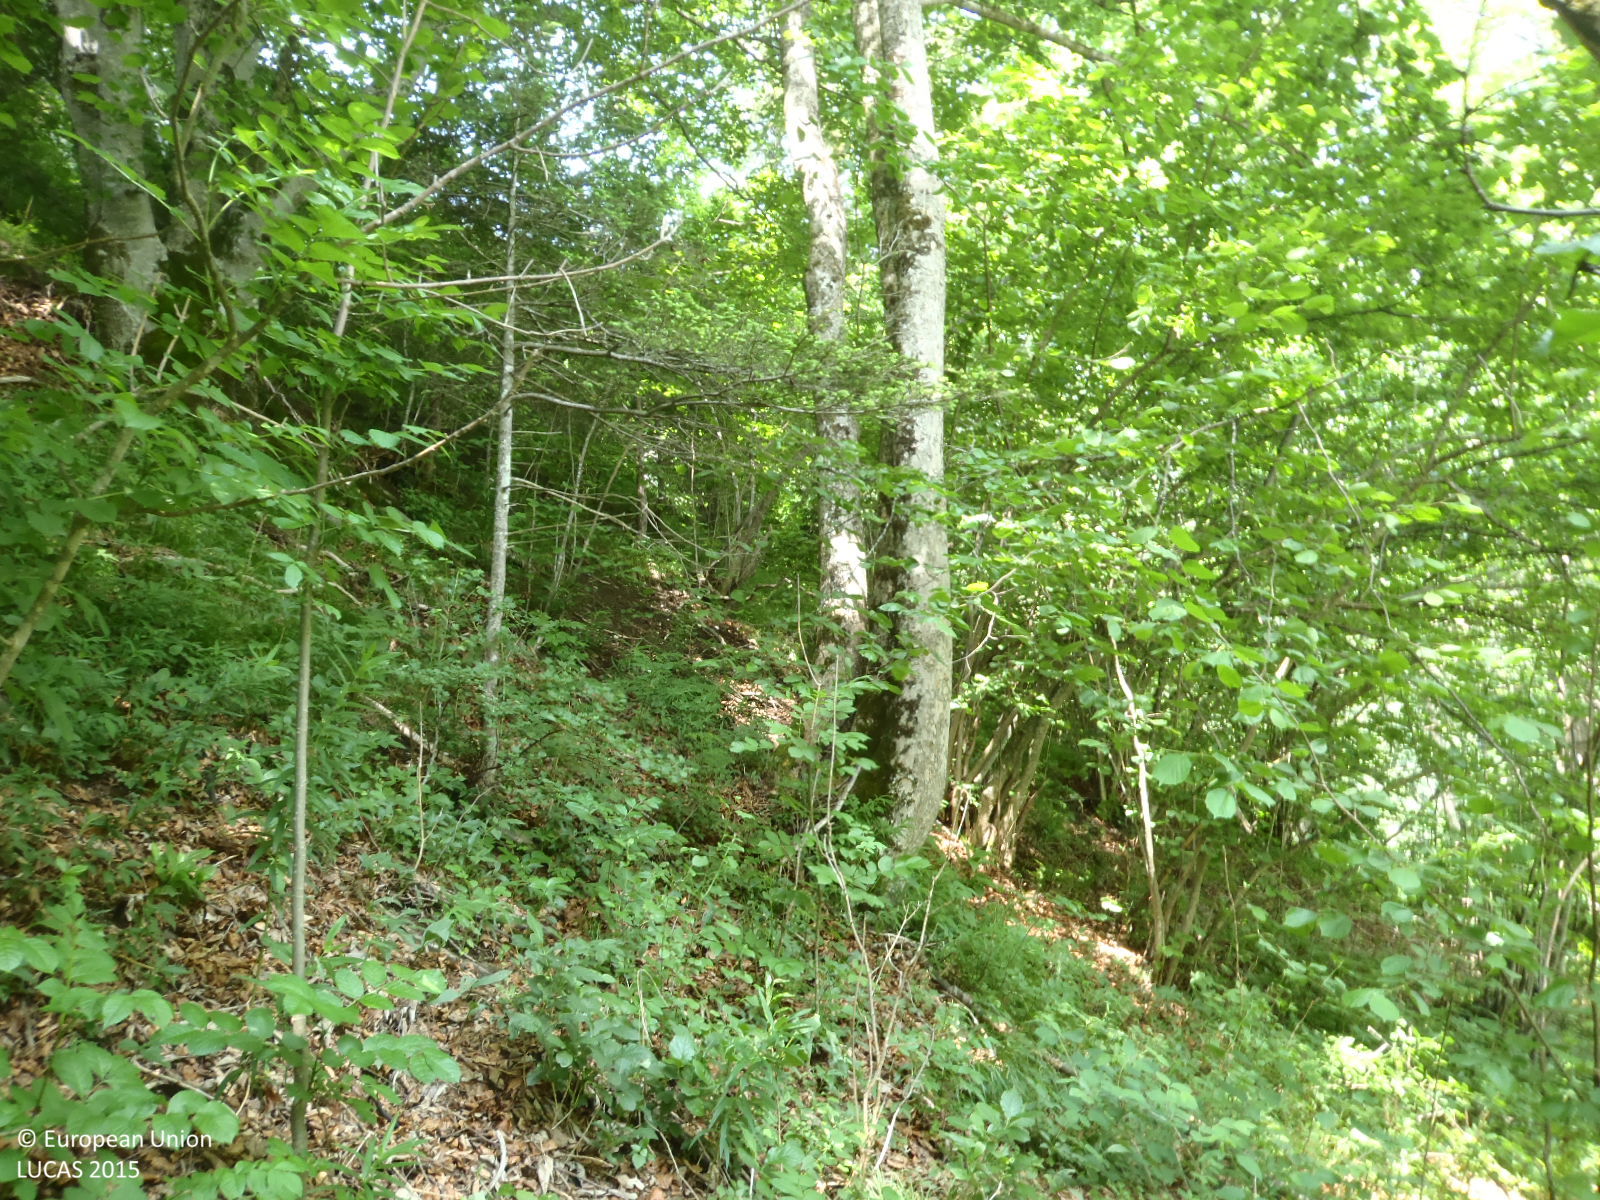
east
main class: Woodland
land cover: Broadleaved woodland
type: mesophytic deciduous forest
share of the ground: > 75 %
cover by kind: broadleaved forest trees 85 %, coniferous forest trees 5 %, shrubs 5 %, herbaceous plants 5 %
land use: Forestry
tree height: > 5 m
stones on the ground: < 10 %
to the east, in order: Broadleaved woodland; Shrubland without tree cover; Spruce dominated coniferous woodland; Grassland without tree/shrub cover; Tracks; Fences; Grassland without tree/shrub cover; Tracks; Other mixed woodland; Artificial constructions; Inland fresh running water; Artificial constructions; Spontaneously vegetated surfaces; Grassland without tree/shrub cover; Paved roads, cycling and walking lanes; Grassland without tree/shrub cover; Other mixed woodland; Shrubland without tree cover; Spruce dominated coniferous woodland; Shrubland without tree cover; Electric lines; Railways; Shrubland without tree cover; Spruce dominated coniferous woodland
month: June
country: AT
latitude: 47.4102
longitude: 10.8606
